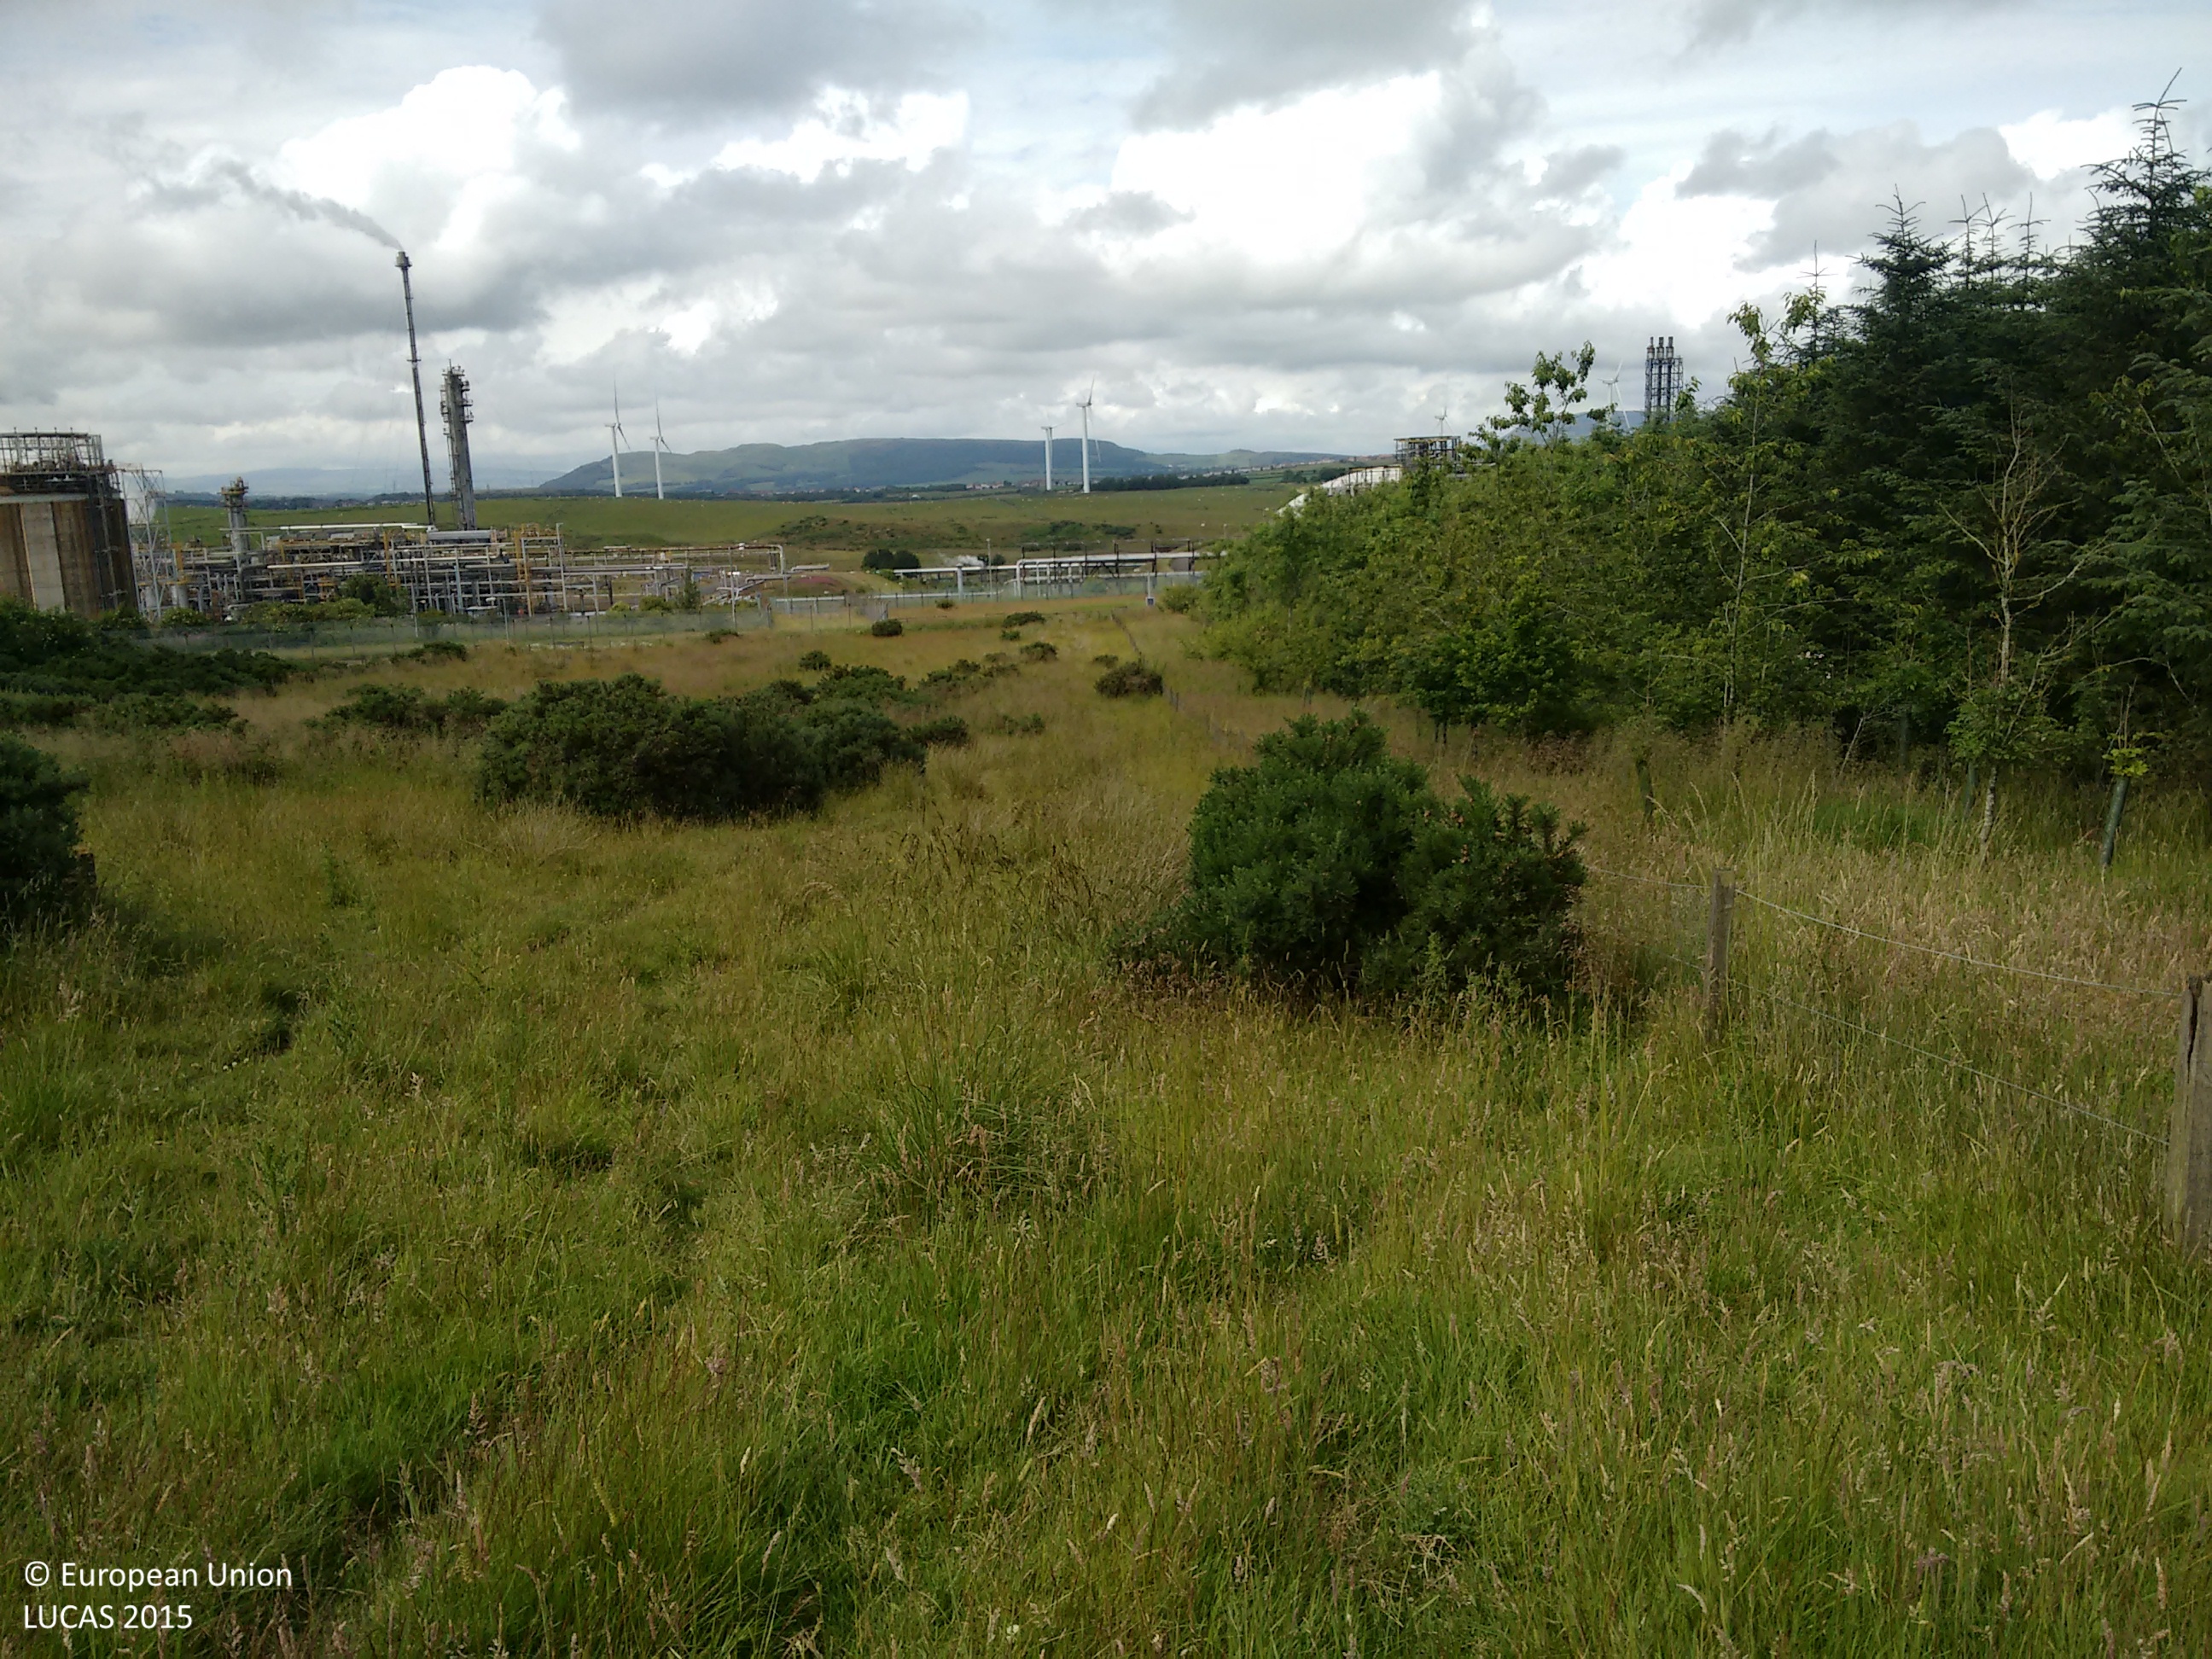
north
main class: Grassland
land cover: Grassland with sparse tree/shrub cover
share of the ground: > 75 %
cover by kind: herbaceous plants 90 %, broadleaved forest trees 5 %, shrubs 5 %
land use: Agriculture (excluding fallow land and kitchen gardens)
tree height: < 5 m
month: July
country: GB
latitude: 56.0935
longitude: -3.3016
